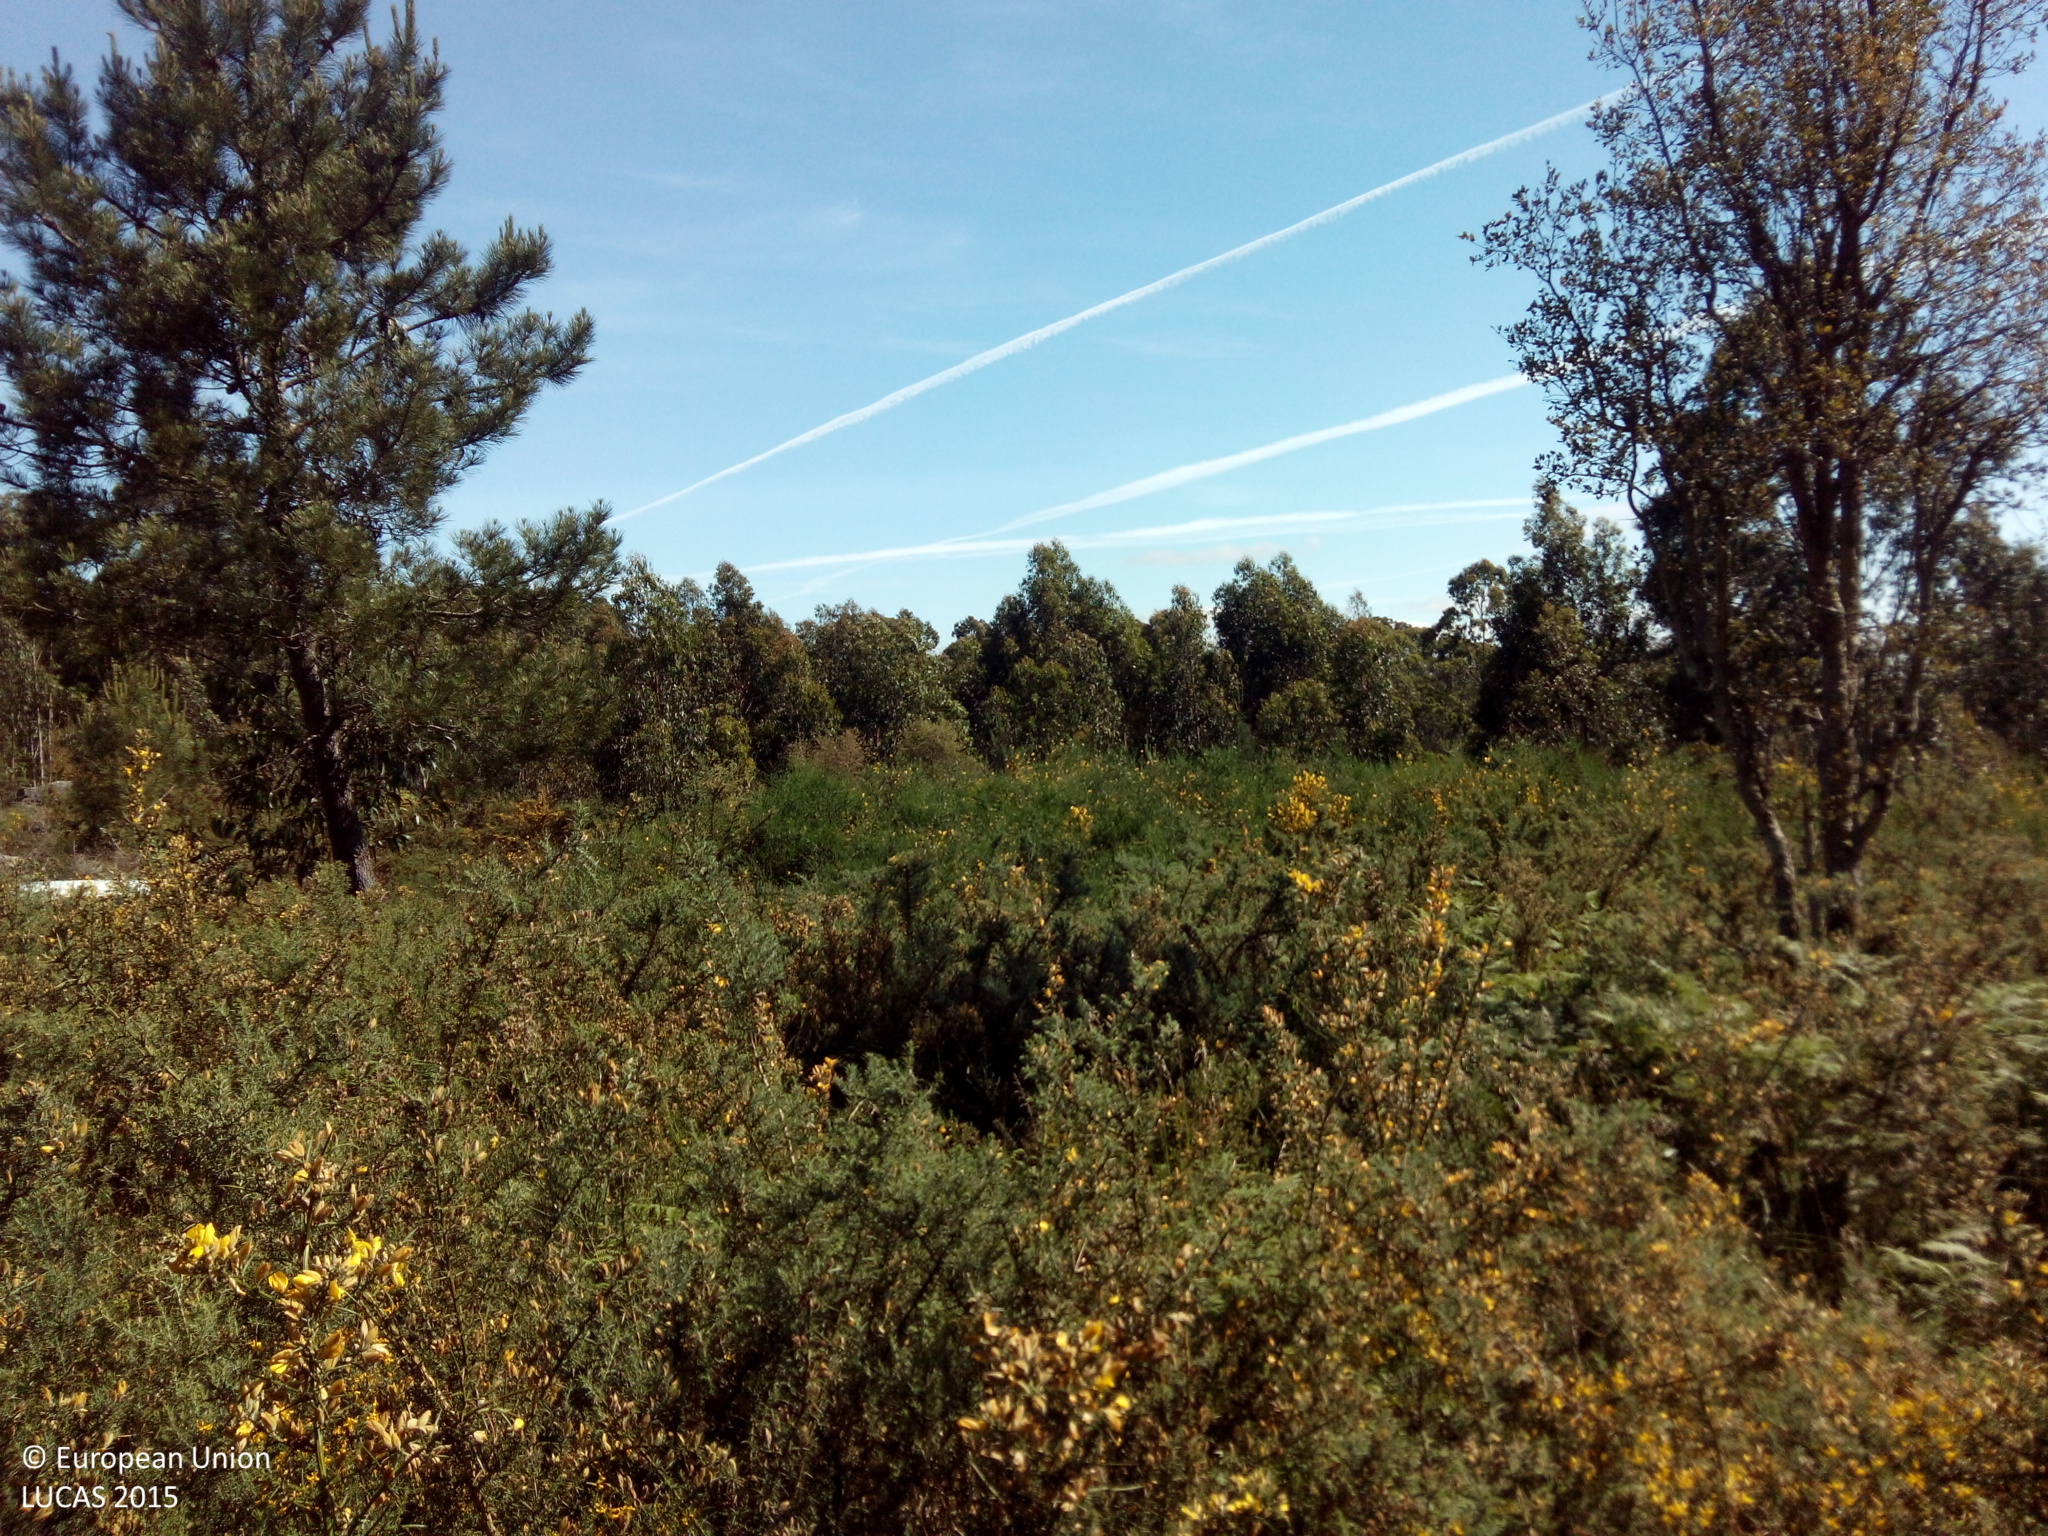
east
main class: Shrubland
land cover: Shrubland without tree cover
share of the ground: > 75 %
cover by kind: shrubs 100 %
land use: Semi-natural and natural areas not in use
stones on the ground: < 10 %
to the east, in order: Shrubland without tree cover; Single bushes/trees; Dry stone walls; Ditches and canals; Paved roads, cycling and walking lanes; Pine dominated mixed woodland; Shrubland without tree cover; Rock outcrops; Tracks; Broadleaved woodland; Shrubland without tree cover
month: May
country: ES
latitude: 42.5555
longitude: -9.0051
